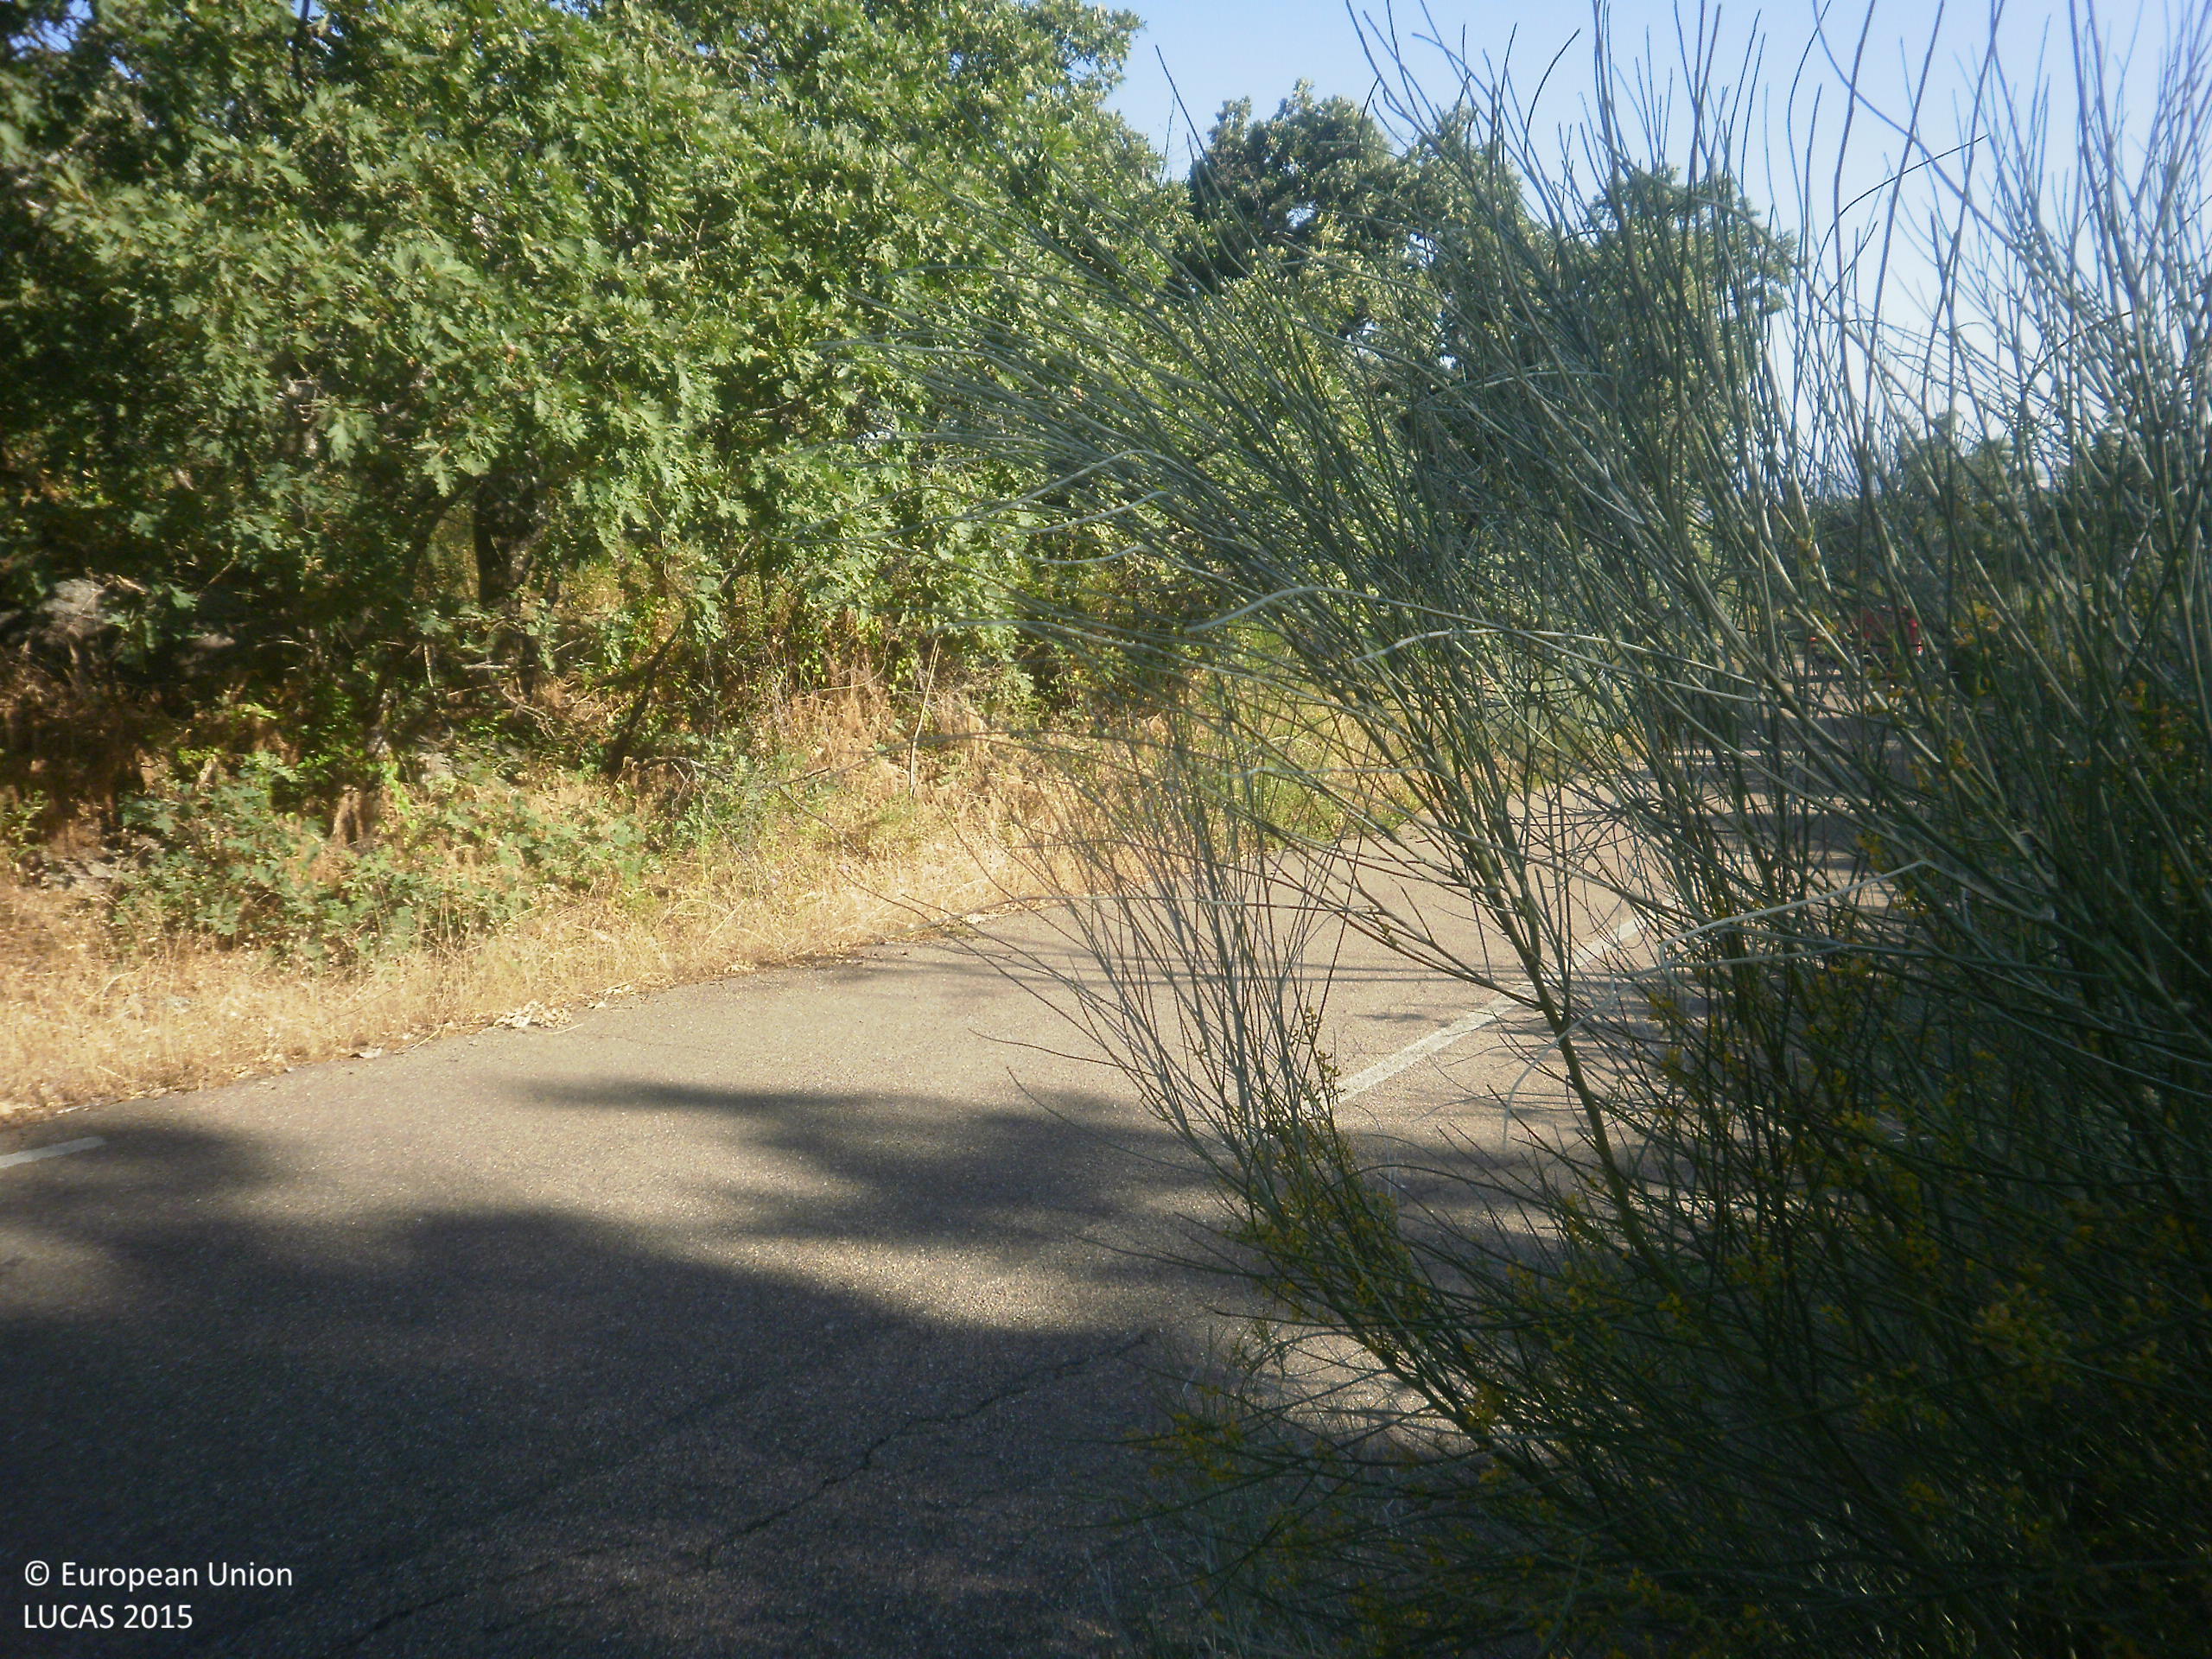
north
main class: Woodland
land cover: Broadleaved woodland
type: thermophilous deciduous forest
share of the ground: 50 - 75 %
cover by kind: broadleaved forest trees 60 %, herbaceous plants 40 %
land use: Forestry
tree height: > 5 m
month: June
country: ES
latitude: 39.2160
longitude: -6.0284
